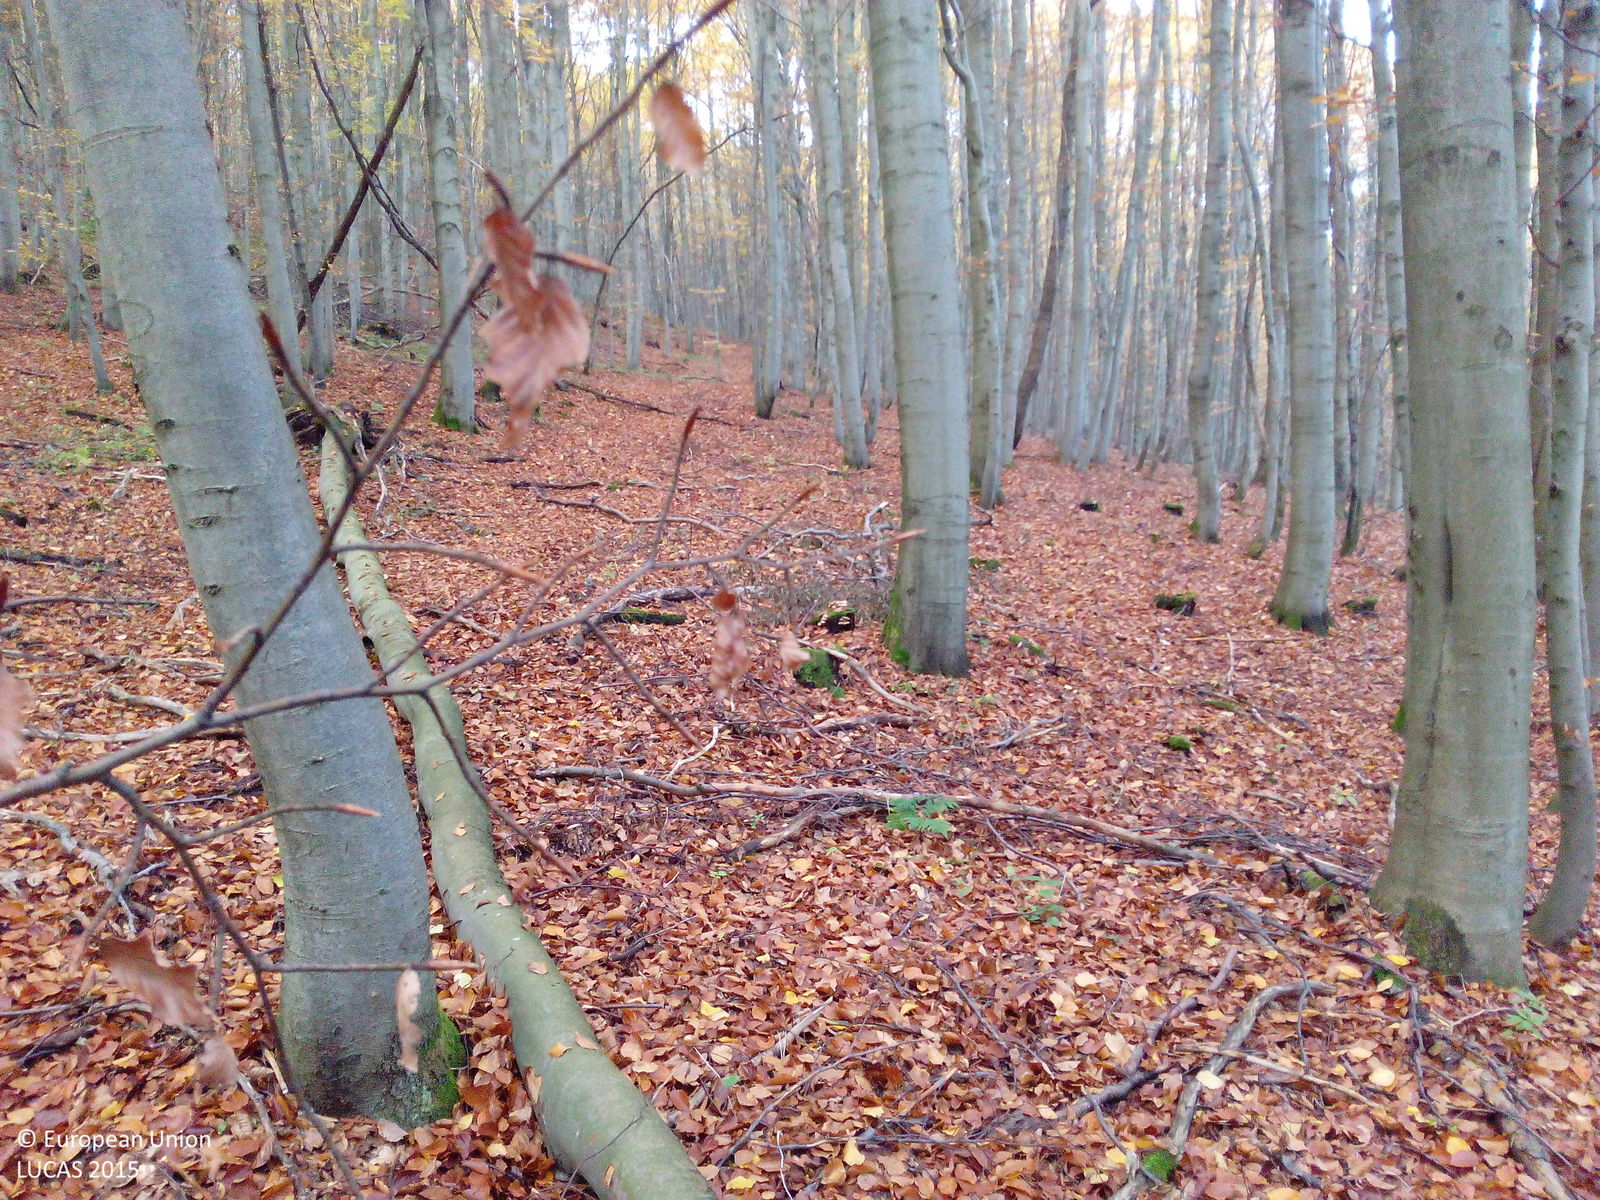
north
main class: Woodland
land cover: Broadleaved woodland
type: mesophytic deciduous forest
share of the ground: > 75 %
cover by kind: broadleaved forest trees 75 %, unconsolidated bare surface 20 %, herbaceous plants 5 %
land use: Forestry
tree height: > 5 m
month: October
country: DE
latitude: 50.3101
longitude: 9.9298
